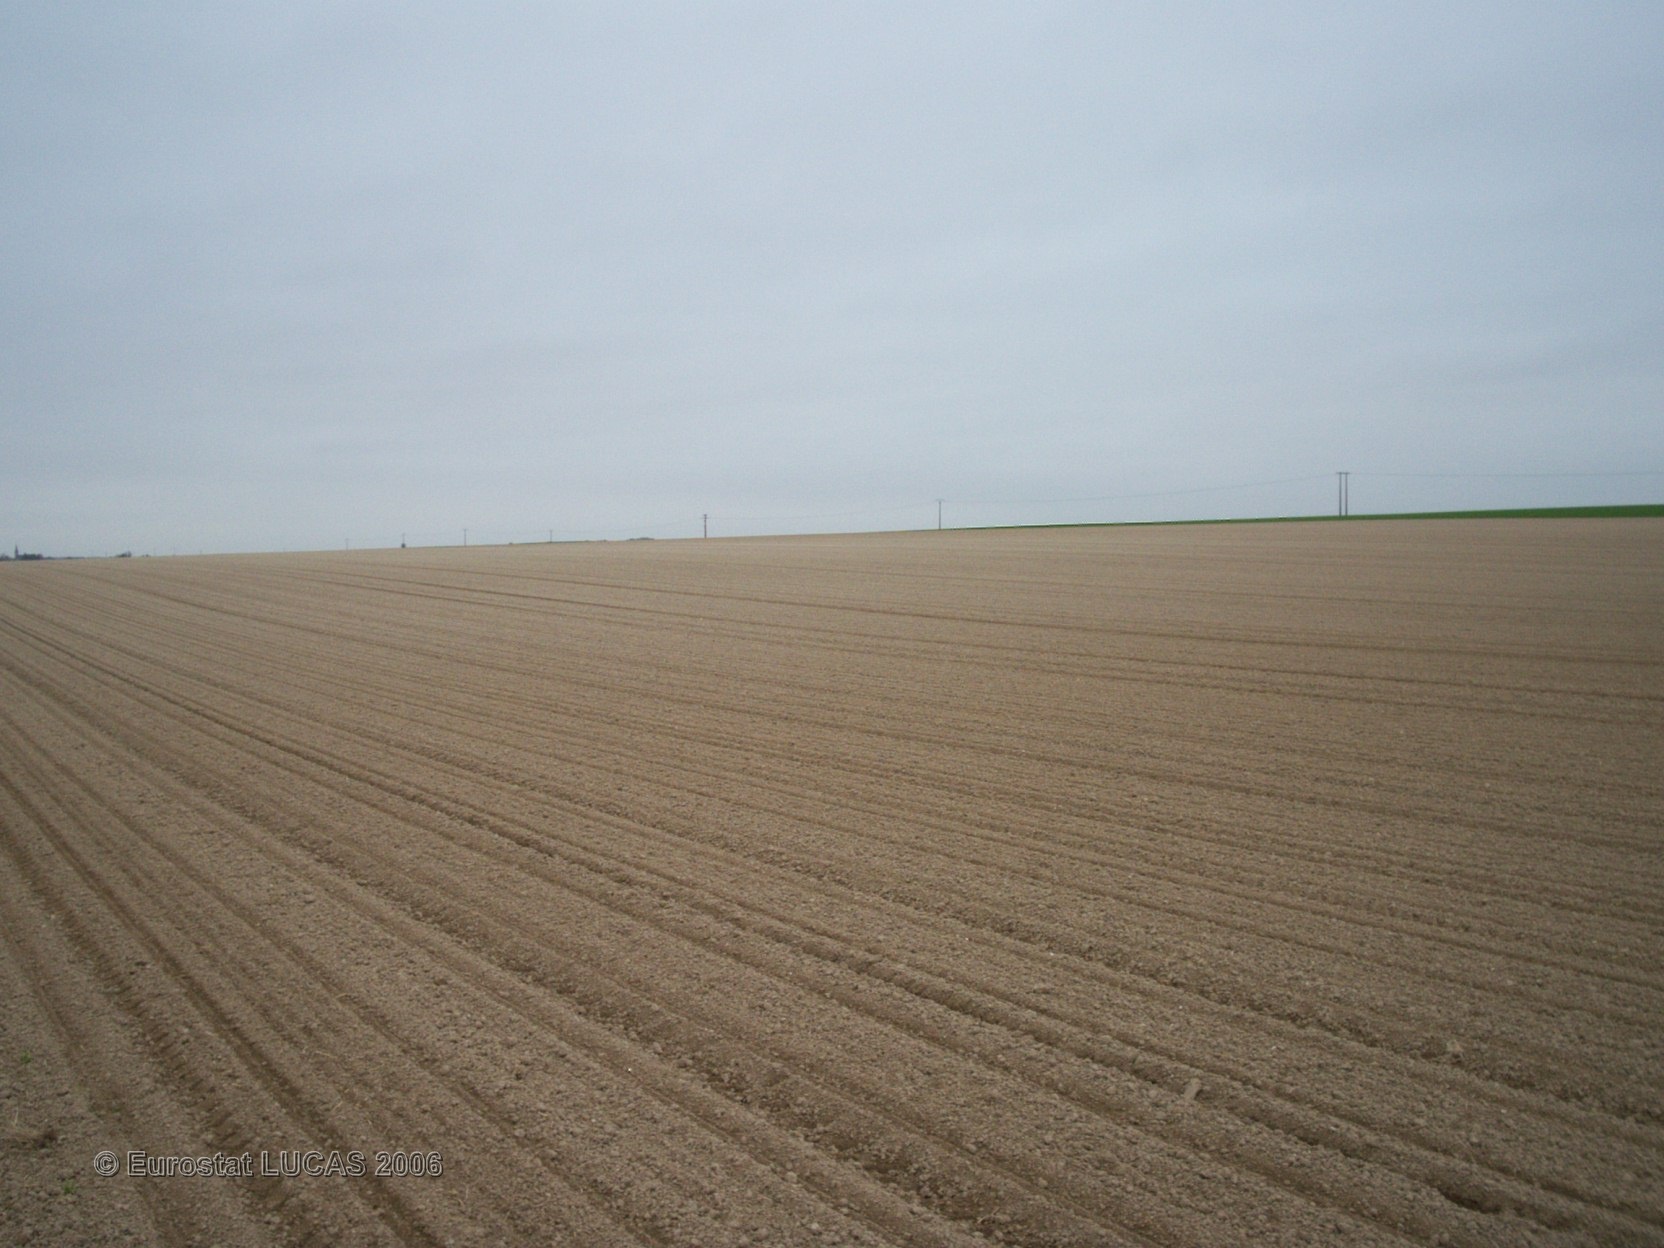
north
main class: Cropland
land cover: Sugar beet
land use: Agriculture (excluding fallow land and kitchen gardens)
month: June
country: FR
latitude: 49.2536
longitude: 4.4044
